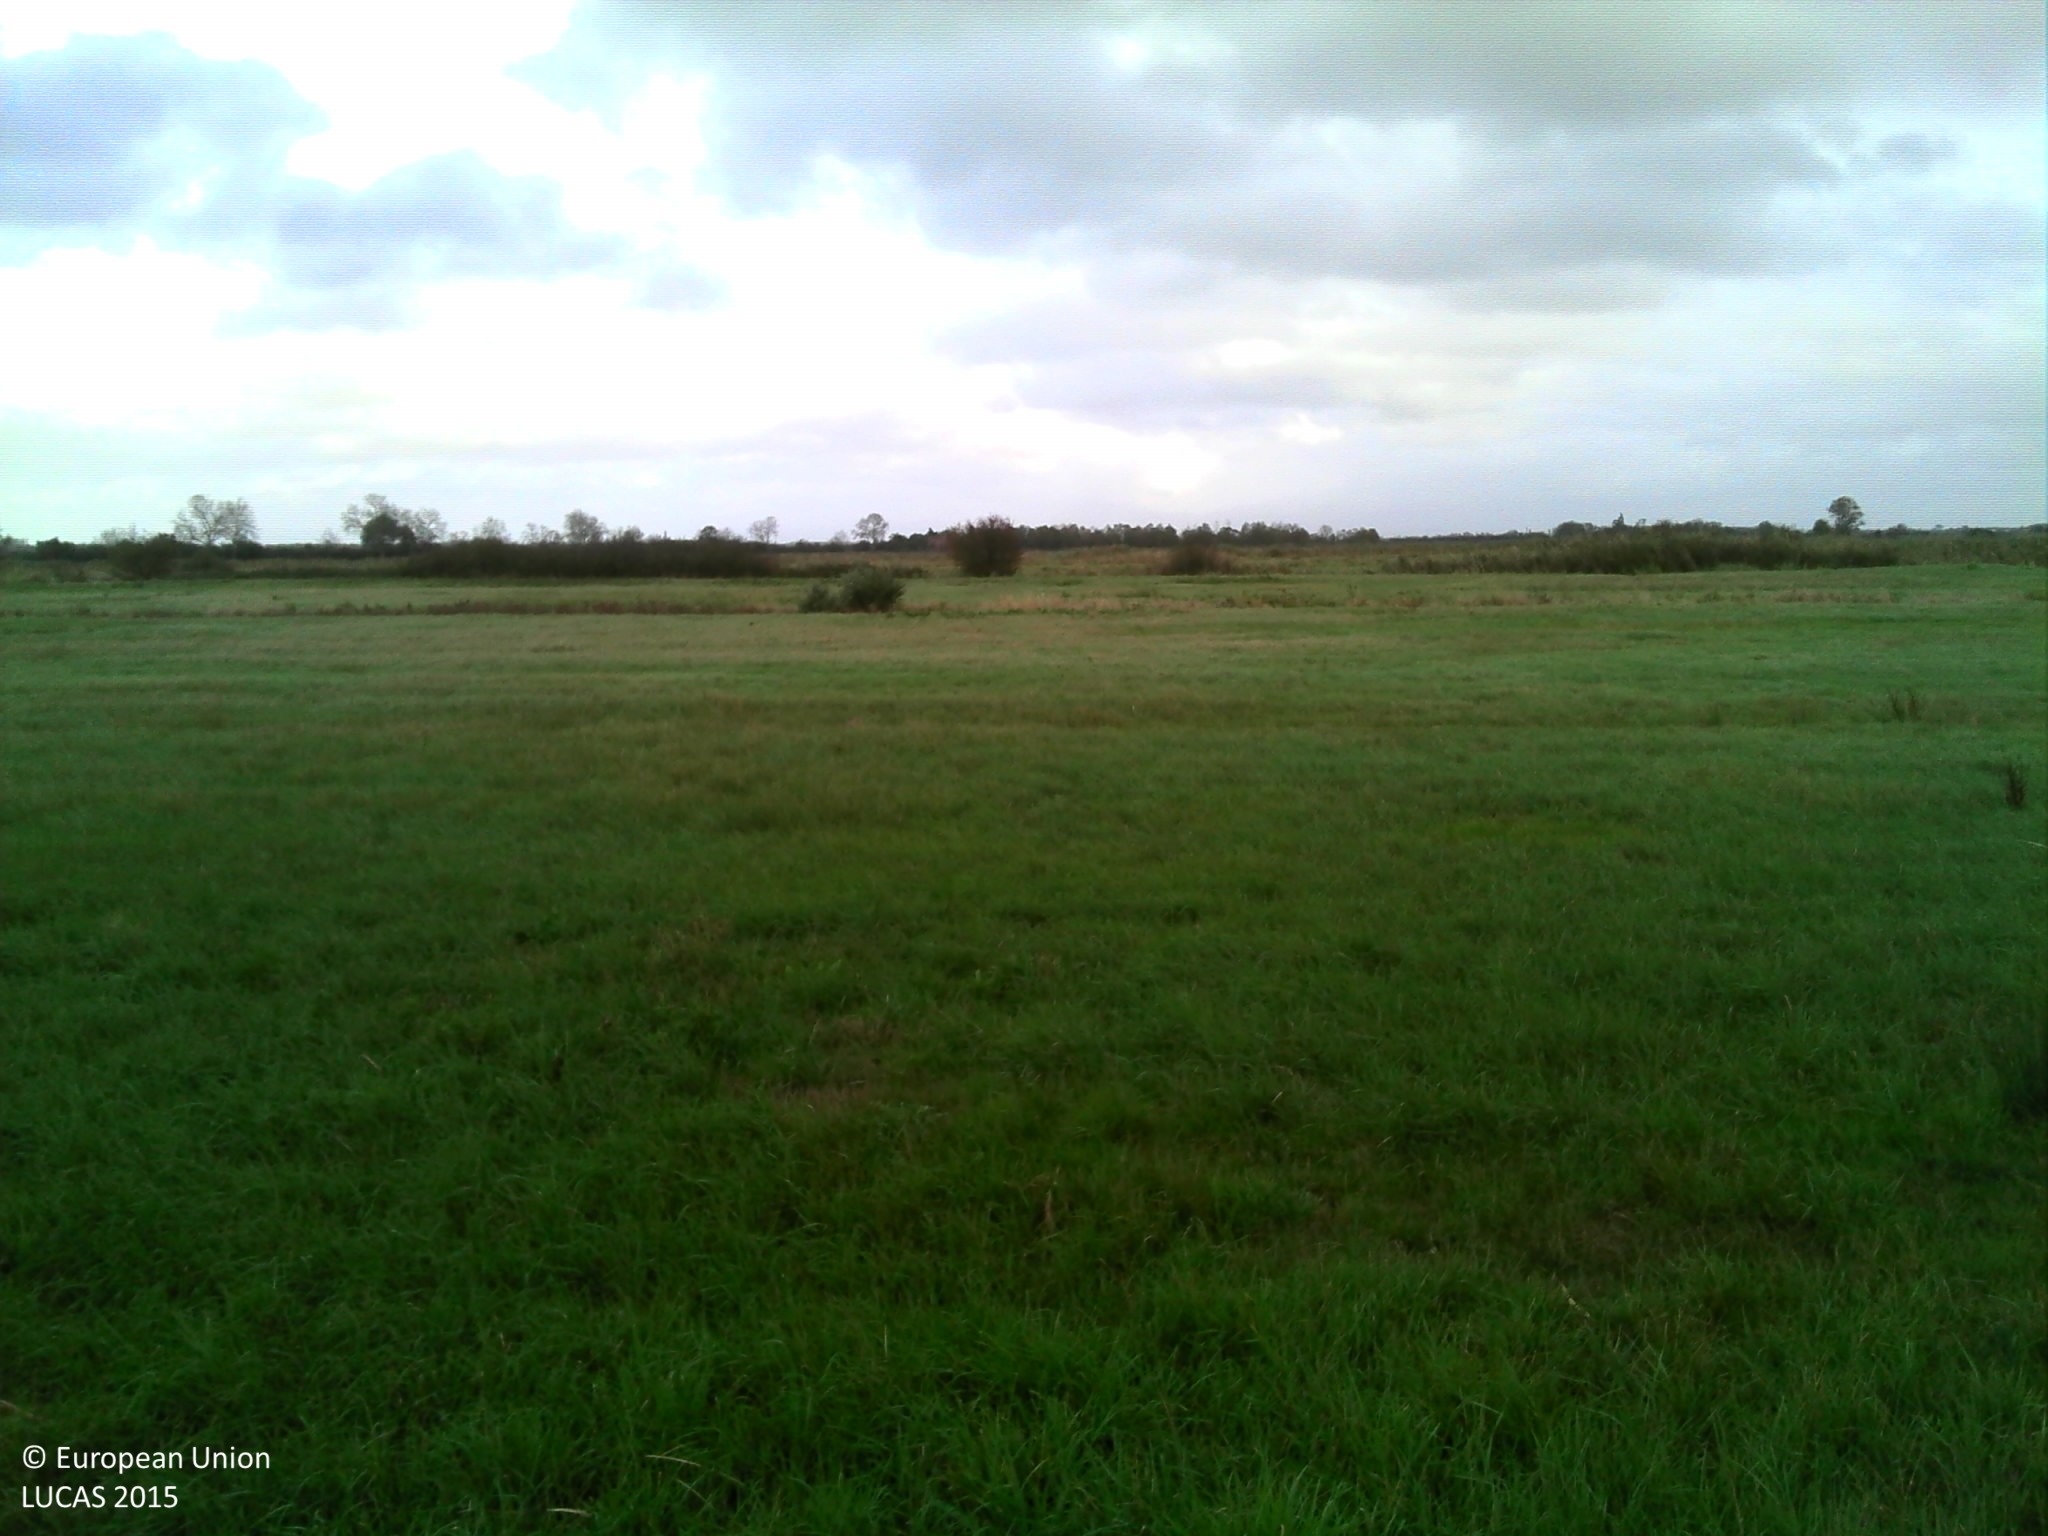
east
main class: Shrubland
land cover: Shrubland without tree cover
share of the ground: > 75 %
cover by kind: shrubs 100 %
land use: Agriculture (excluding fallow land and kitchen gardens)
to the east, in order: Shrubland without tree cover; Grassland without tree/shrub cover; Ditches and canals; Grassland without tree/shrub cover; Fences; Ditches and canals; Fences; Grassland without tree/shrub cover; Fences; Ditches and canals; Grassland without tree/shrub cover; Ditches and canals; Grassland without tree/shrub cover; Fences; Ditches and canals; Other bare soil
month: October
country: FR
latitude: 46.4278
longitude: -1.0805
